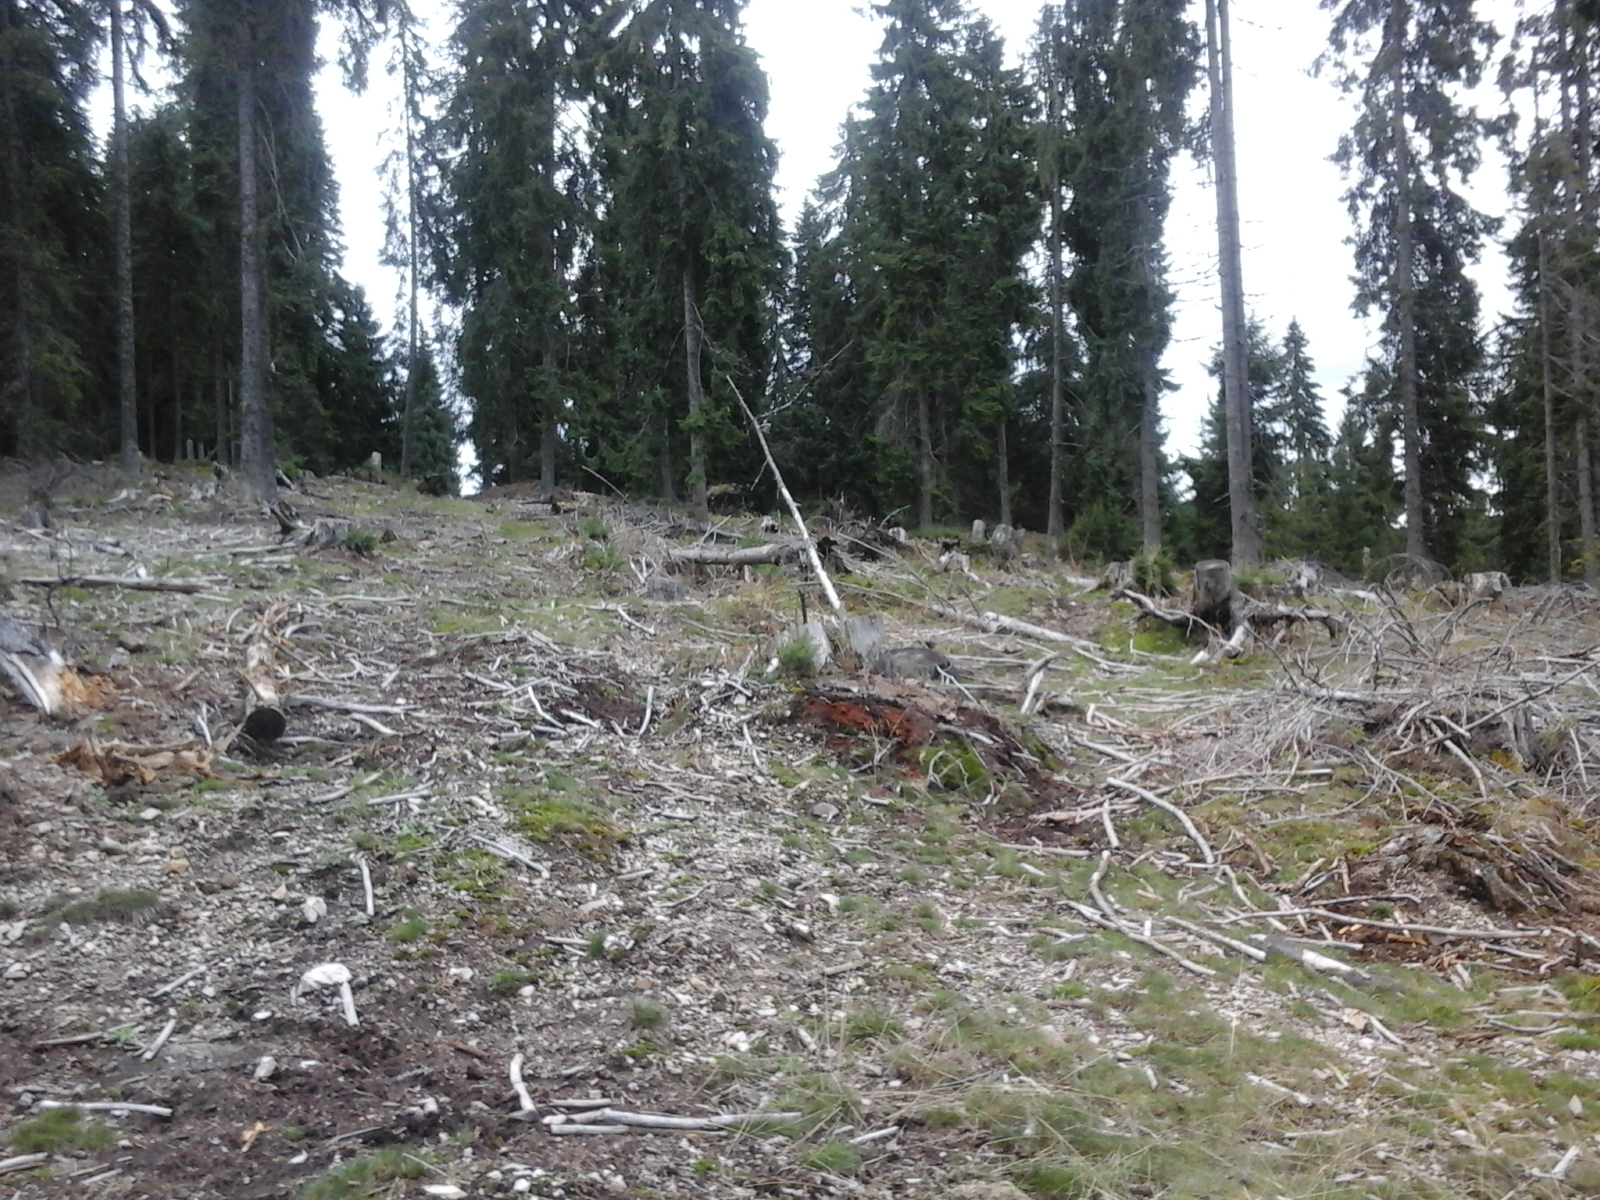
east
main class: Grassland
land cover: Grassland with sparse tree/shrub cover
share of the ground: > 75 %
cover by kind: herbaceous plants 95 %, coniferous forest trees 5 %
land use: Forestry
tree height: > 5 m
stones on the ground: 10 - 25 %
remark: Clear cut
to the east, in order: Grassland with sparse tree/shrub cover; Spruce dominated coniferous woodland; Grassland without tree/shrub cover
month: September
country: RO
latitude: 46.5386
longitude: 22.8488
